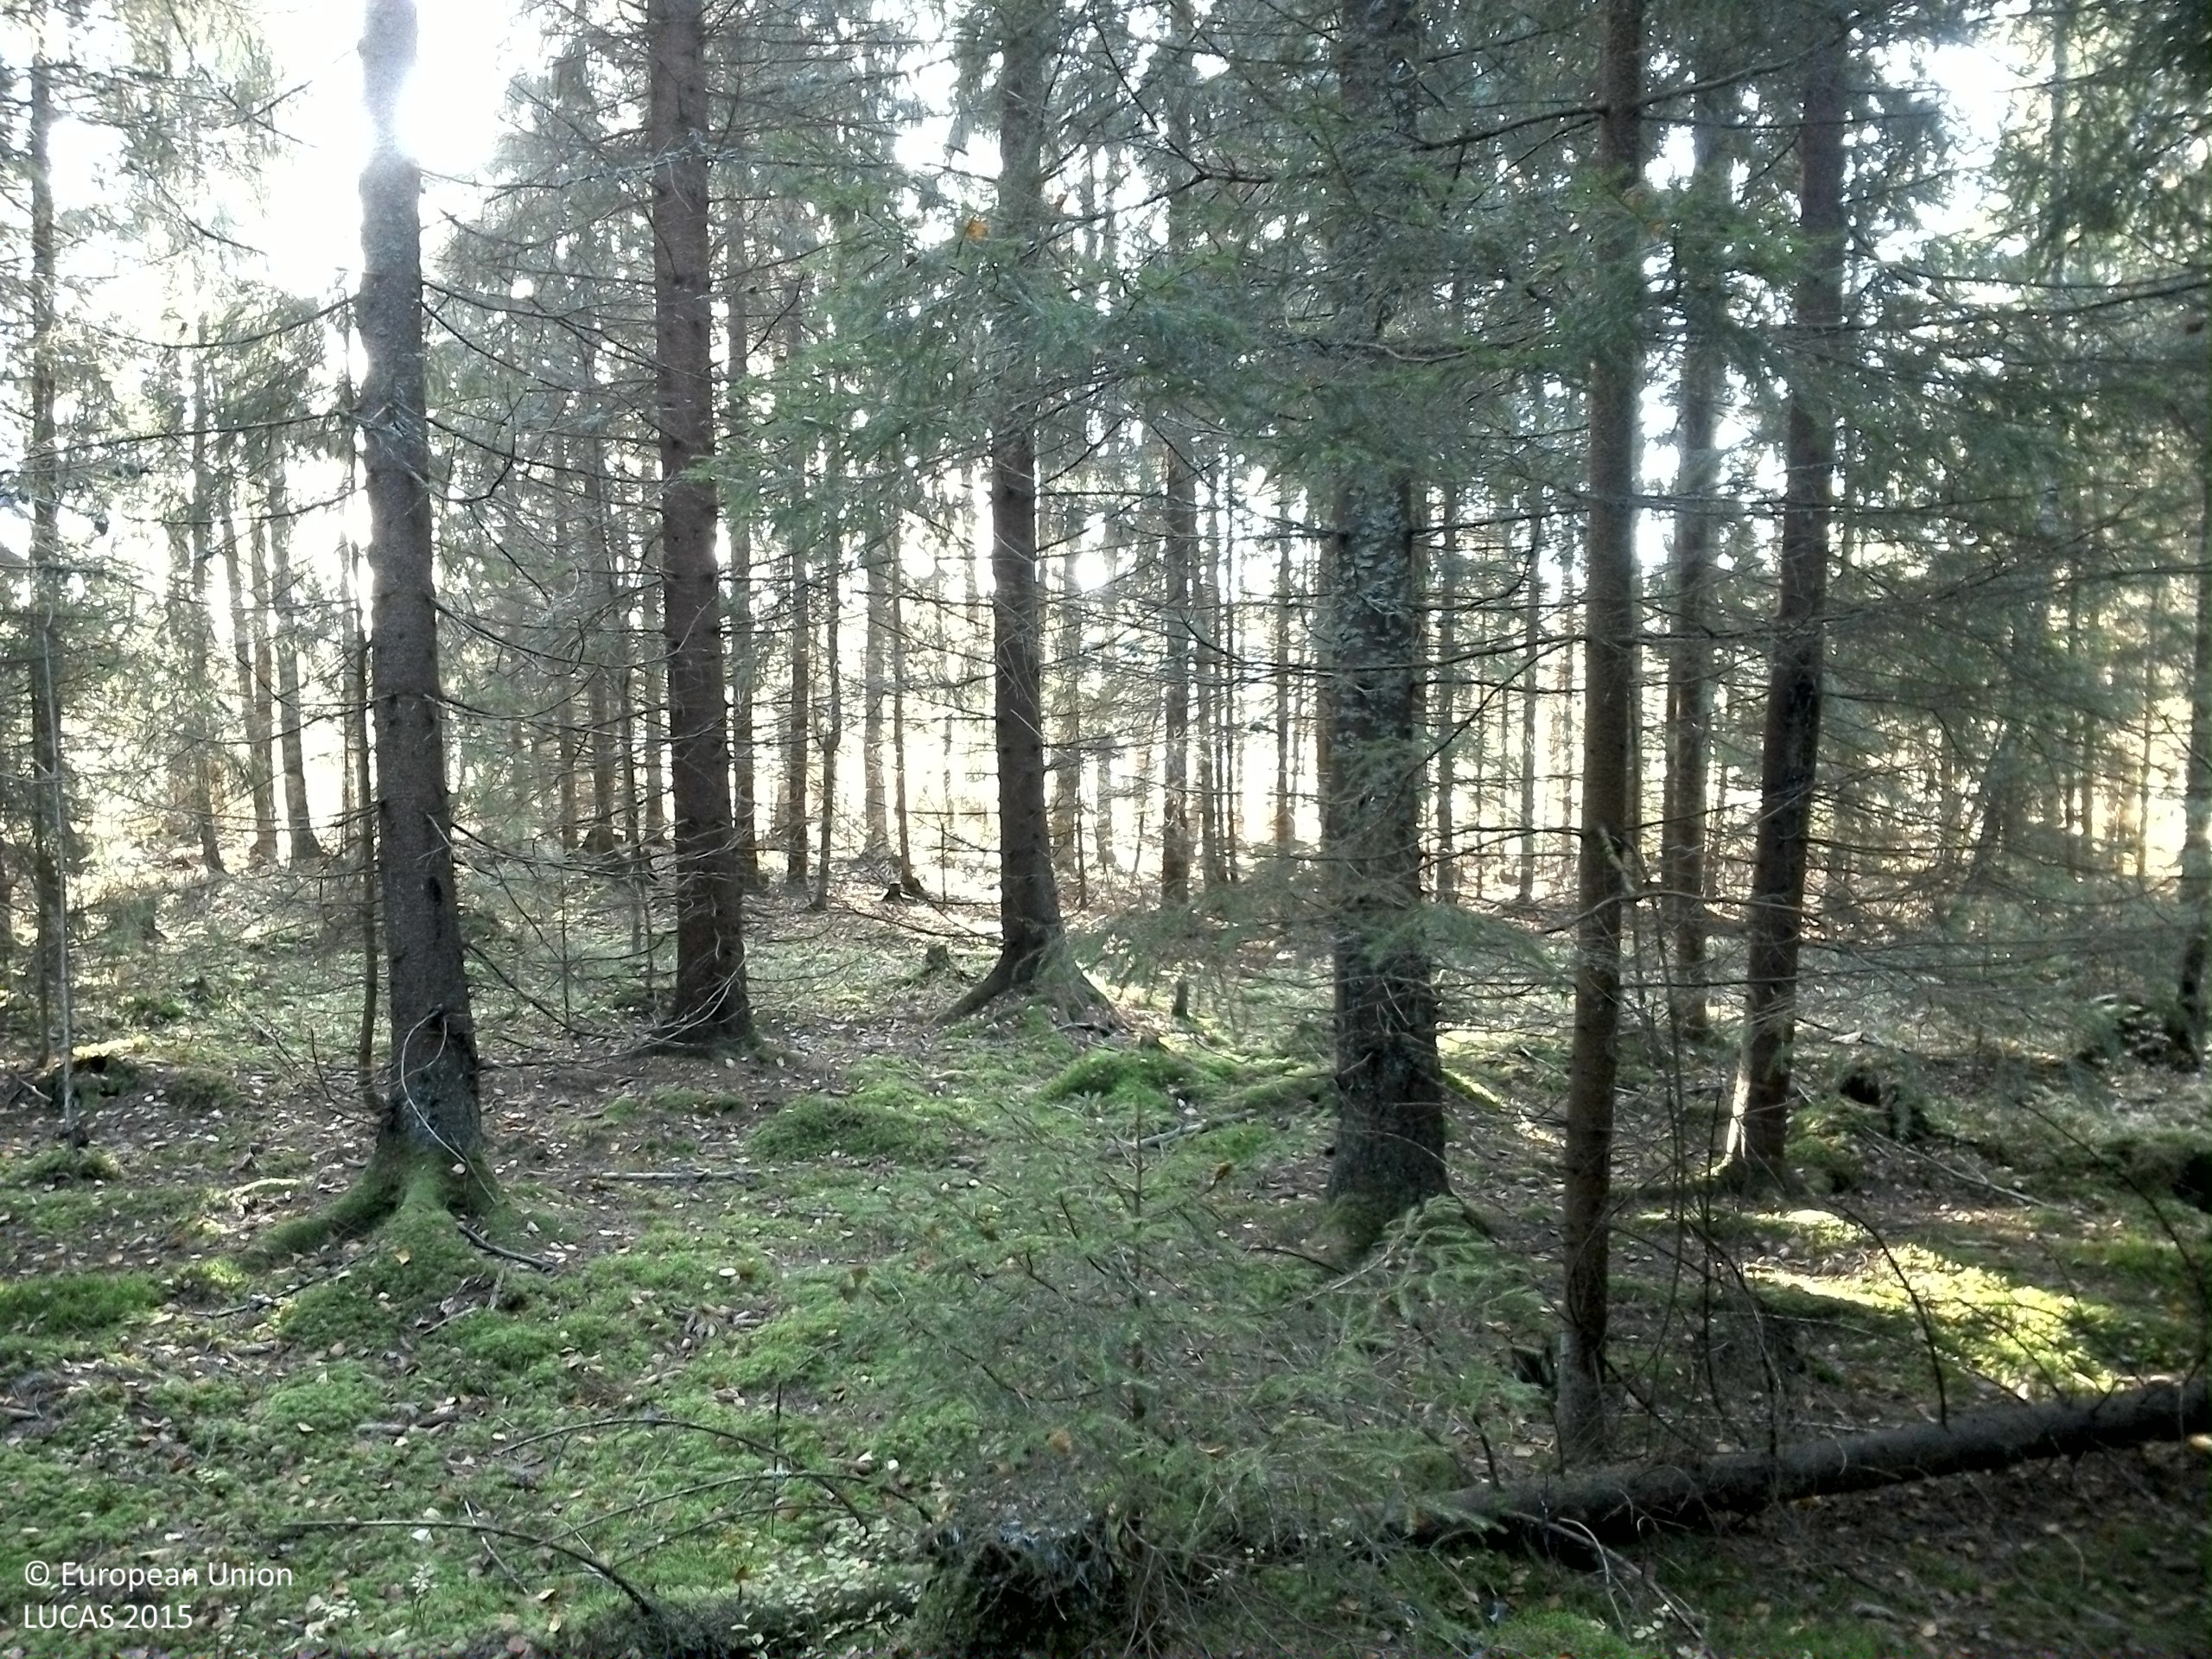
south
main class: Woodland
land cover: Spruce dominated coniferous woodland
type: boreal forest
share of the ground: > 75 %
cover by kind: coniferous forest trees 75 %, shrubs 10 %, lichens and mosses 10 %, broadleaved forest trees 5 %
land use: Forestry
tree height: > 5 m
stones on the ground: < 10 %
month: October
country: SE
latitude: 59.7961
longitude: 16.4959
